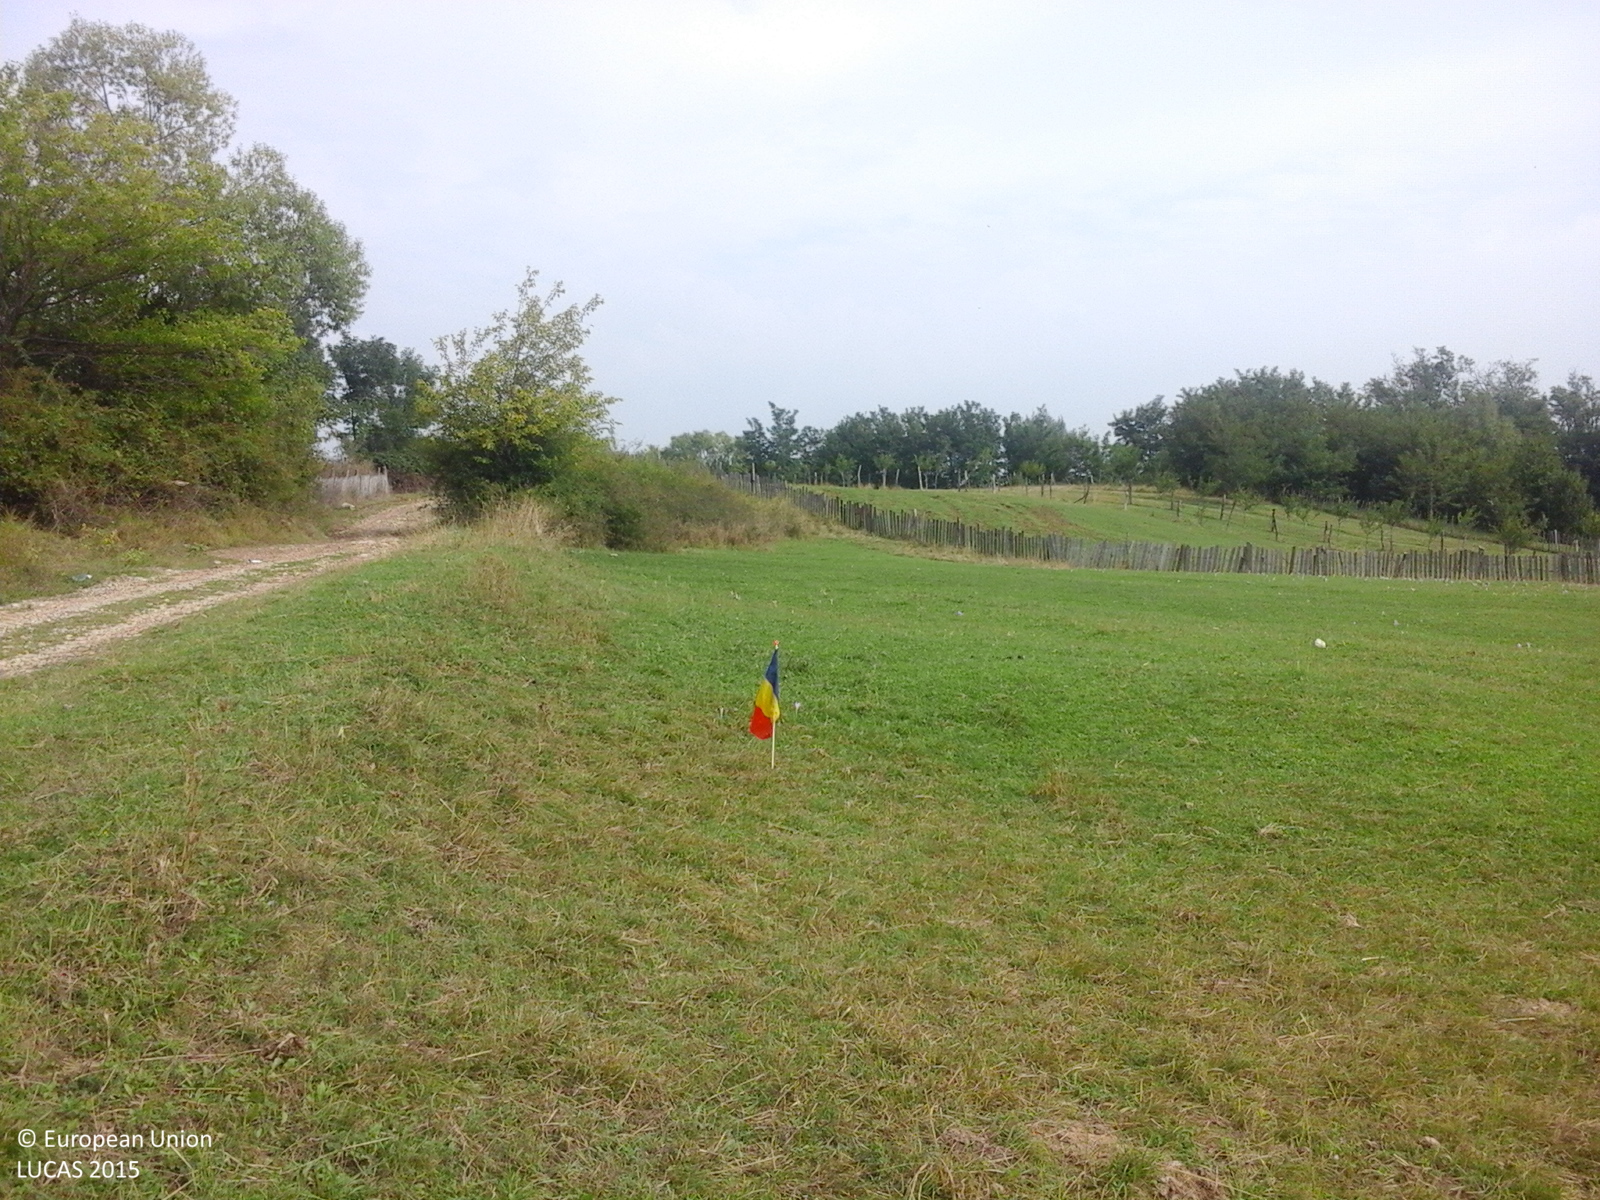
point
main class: Grassland
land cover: Grassland without tree/shrub cover
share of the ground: > 75 %
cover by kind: herbaceous plants 100 %
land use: Agriculture (excluding fallow land and kitchen gardens)
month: September
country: RO
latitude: 45.1582
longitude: 23.2459
